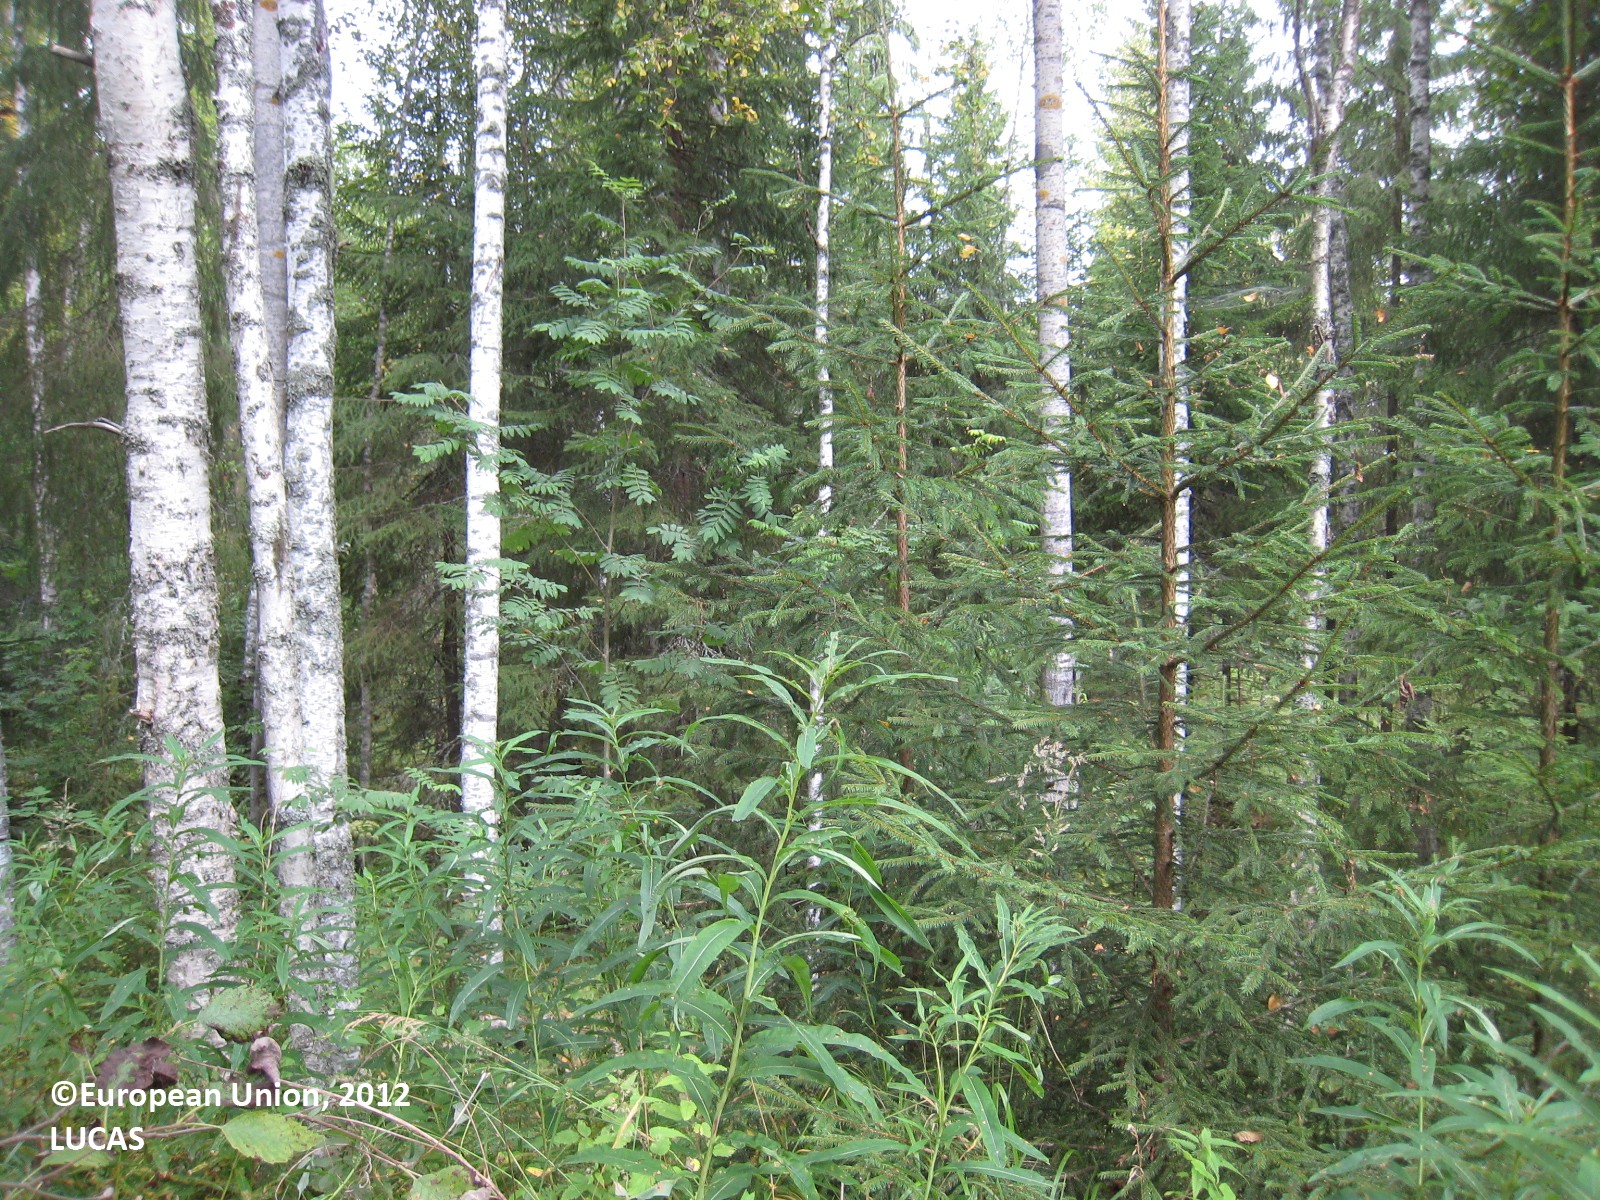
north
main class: Woodland
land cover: Spruce dominated mixed woodland
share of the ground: 50 - 75 %
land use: Forestry
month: August
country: FI
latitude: 62.3675
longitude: 27.3853
